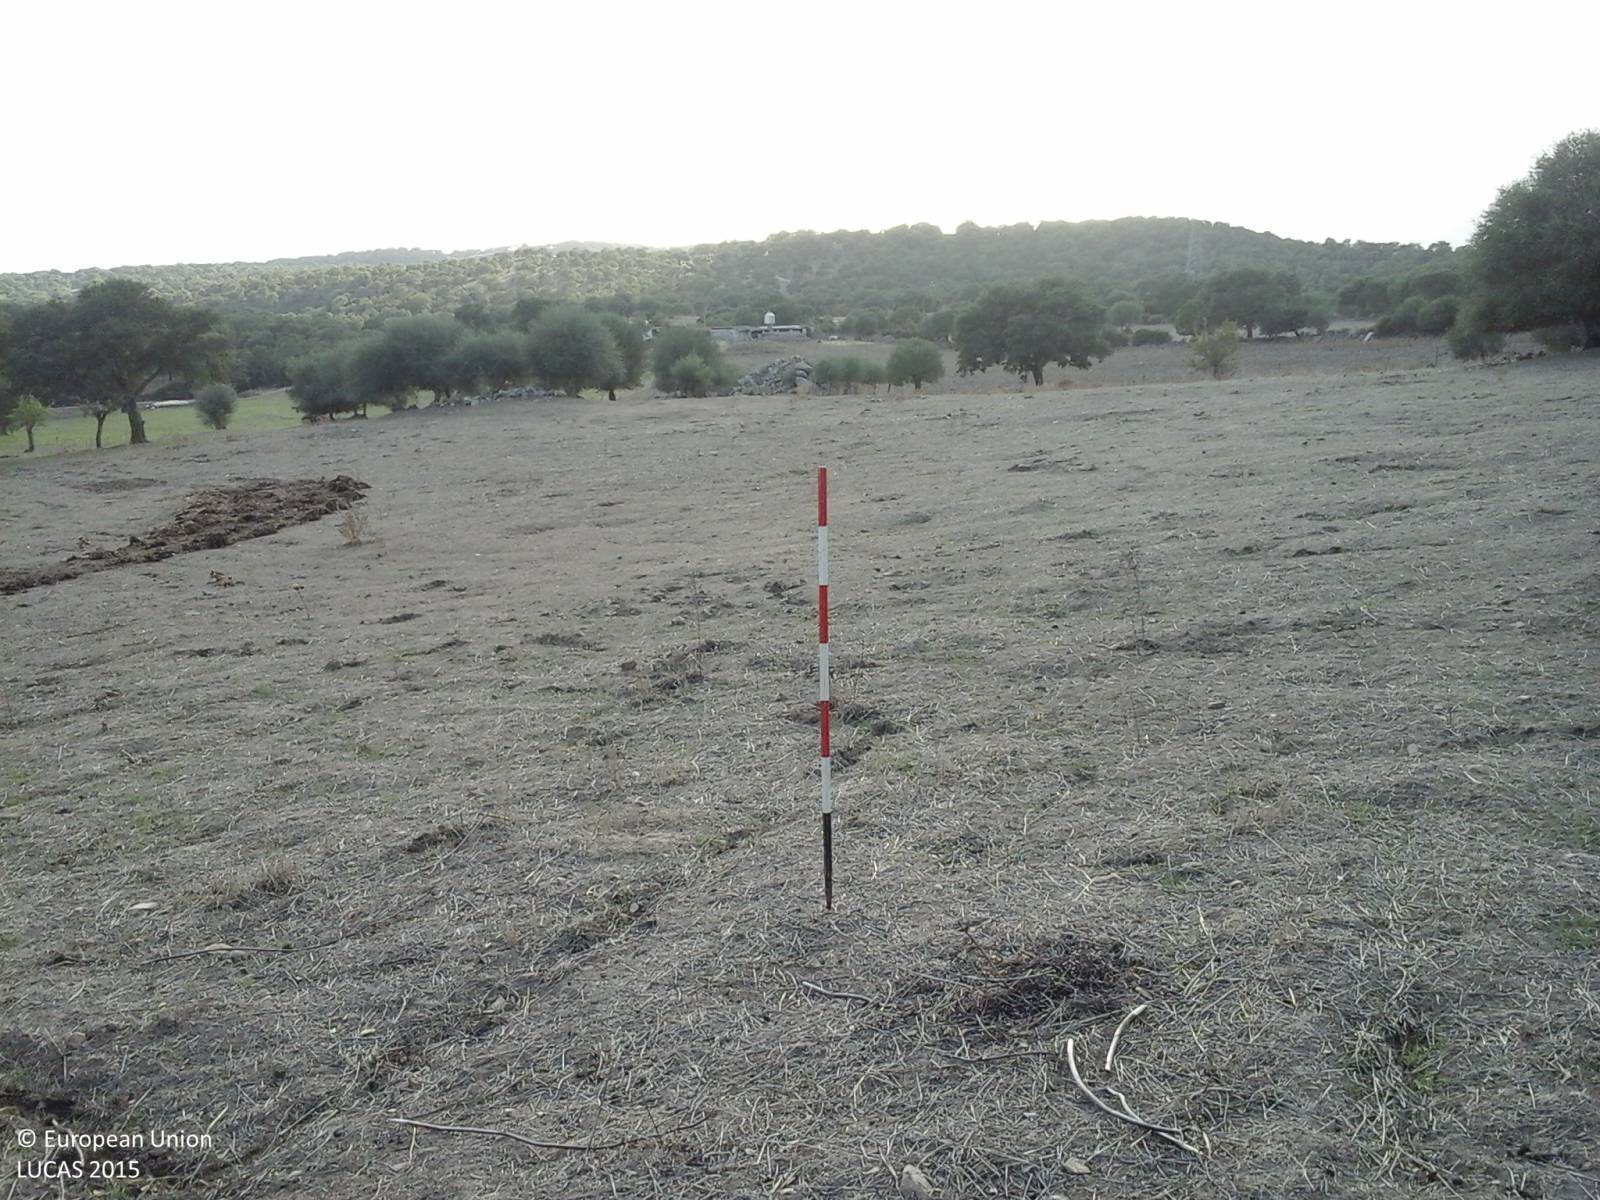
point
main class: Grassland
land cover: Grassland without tree/shrub cover
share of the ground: > 75 %
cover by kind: herbaceous plants 100 %
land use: Agriculture (excluding fallow land and kitchen gardens)
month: October
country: IT
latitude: 40.3535
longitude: 9.0746
